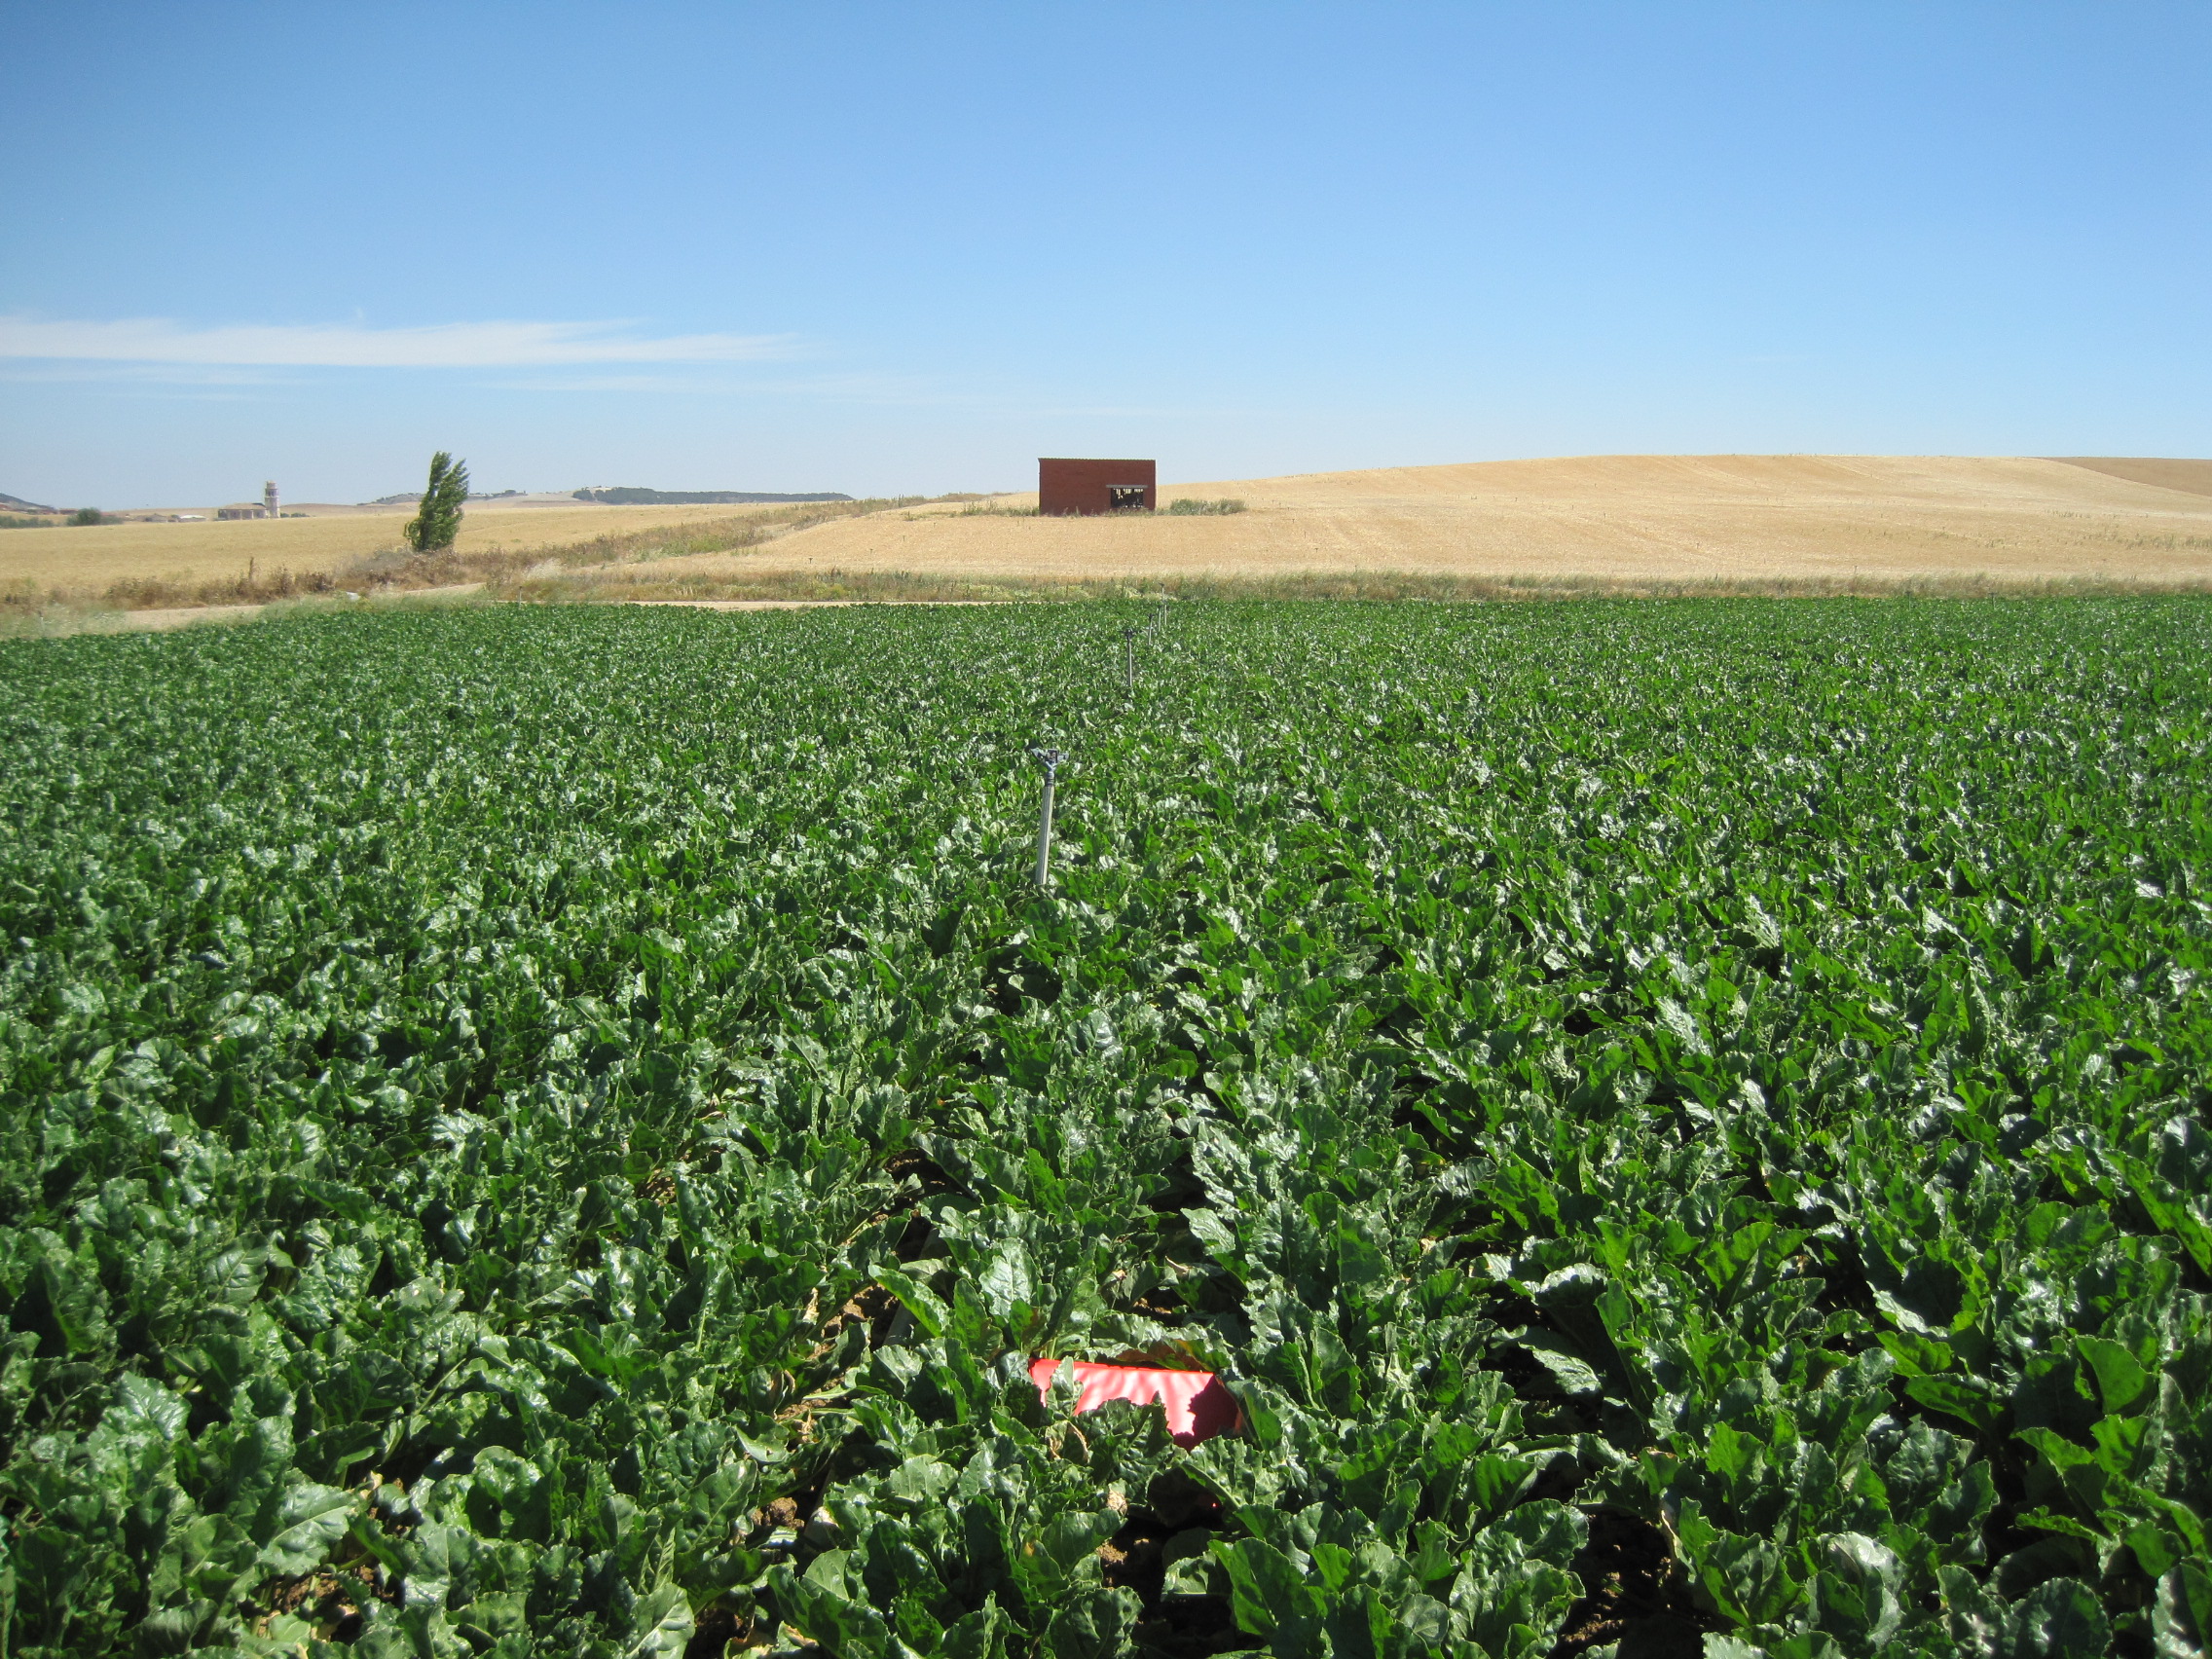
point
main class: Cropland
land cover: Sugar beet
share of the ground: > 75 %
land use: Agriculture (excluding fallow land and kitchen gardens)
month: June
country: ES
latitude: 41.6468
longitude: -5.1939
